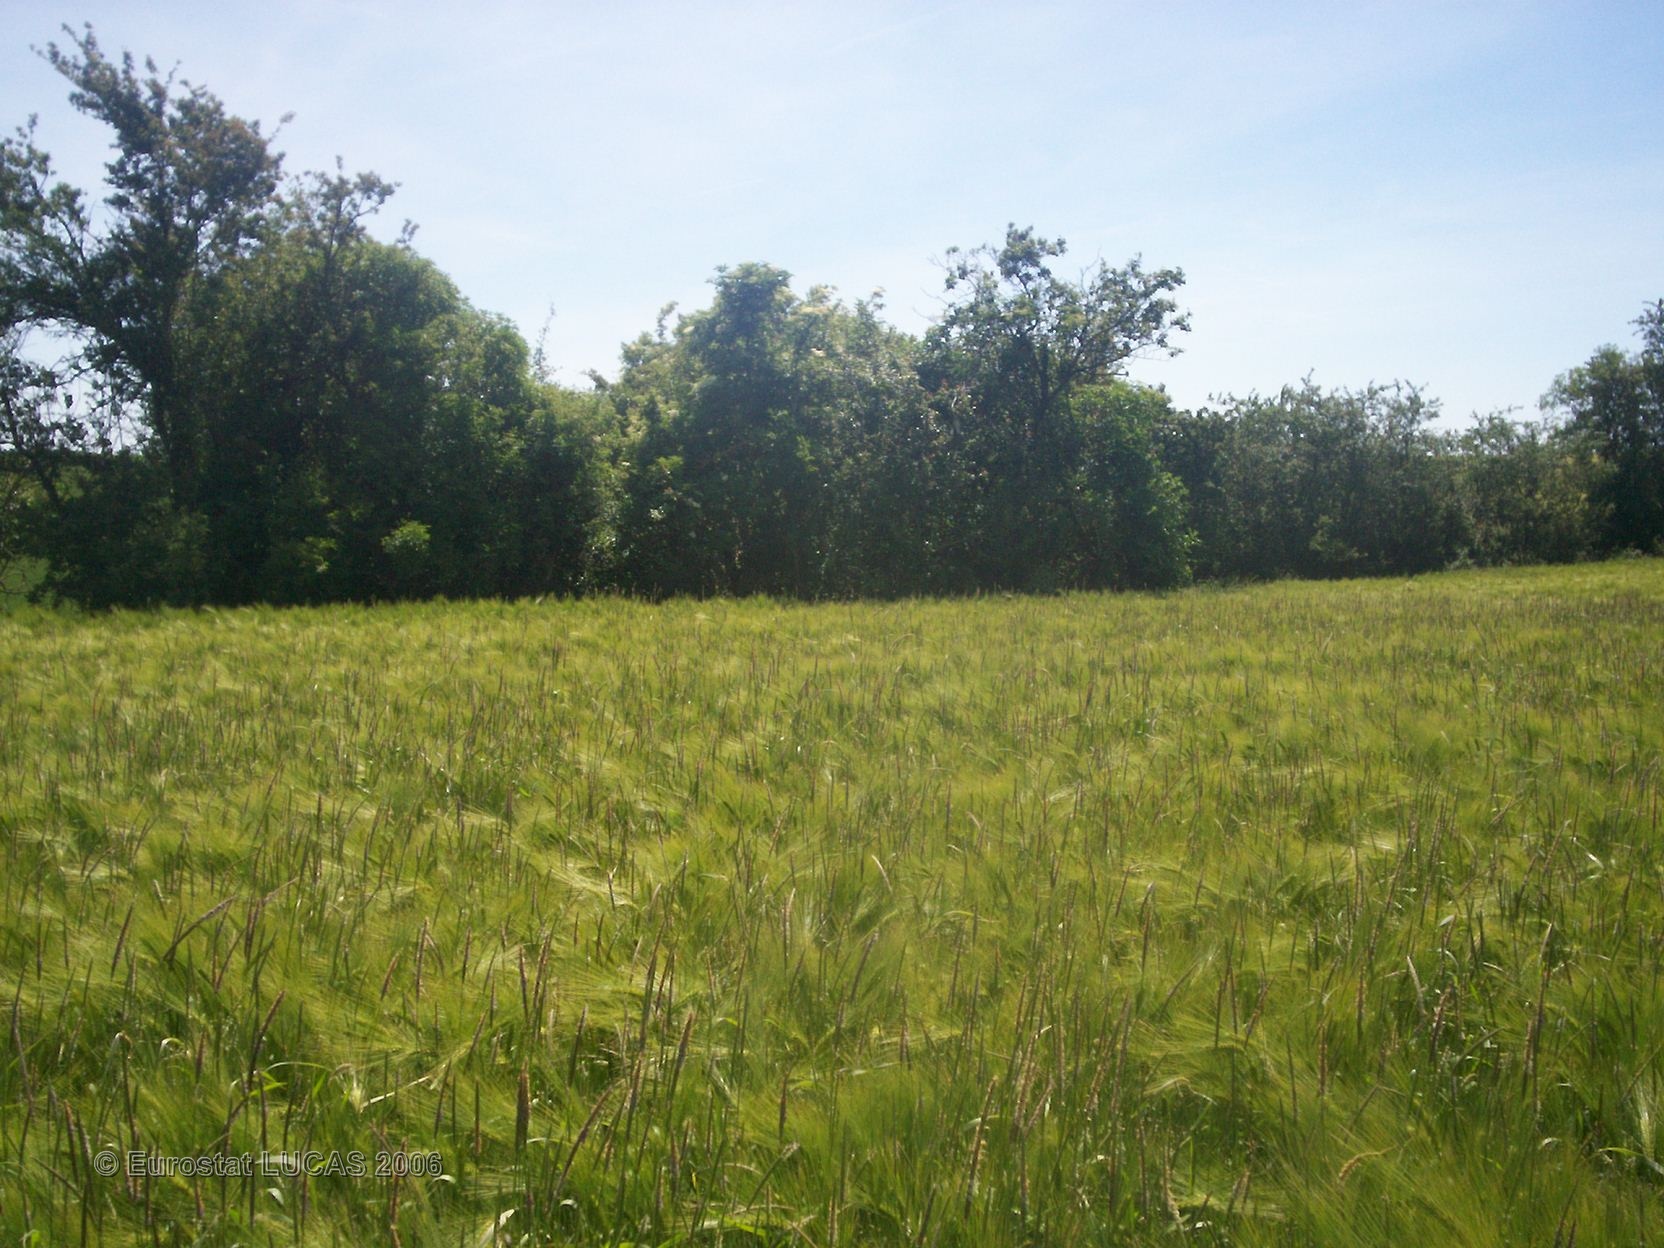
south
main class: Cropland
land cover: Barley
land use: Agriculture (excluding fallow land and kitchen gardens)
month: June
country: FR
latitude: 50.2486
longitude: 2.5693
